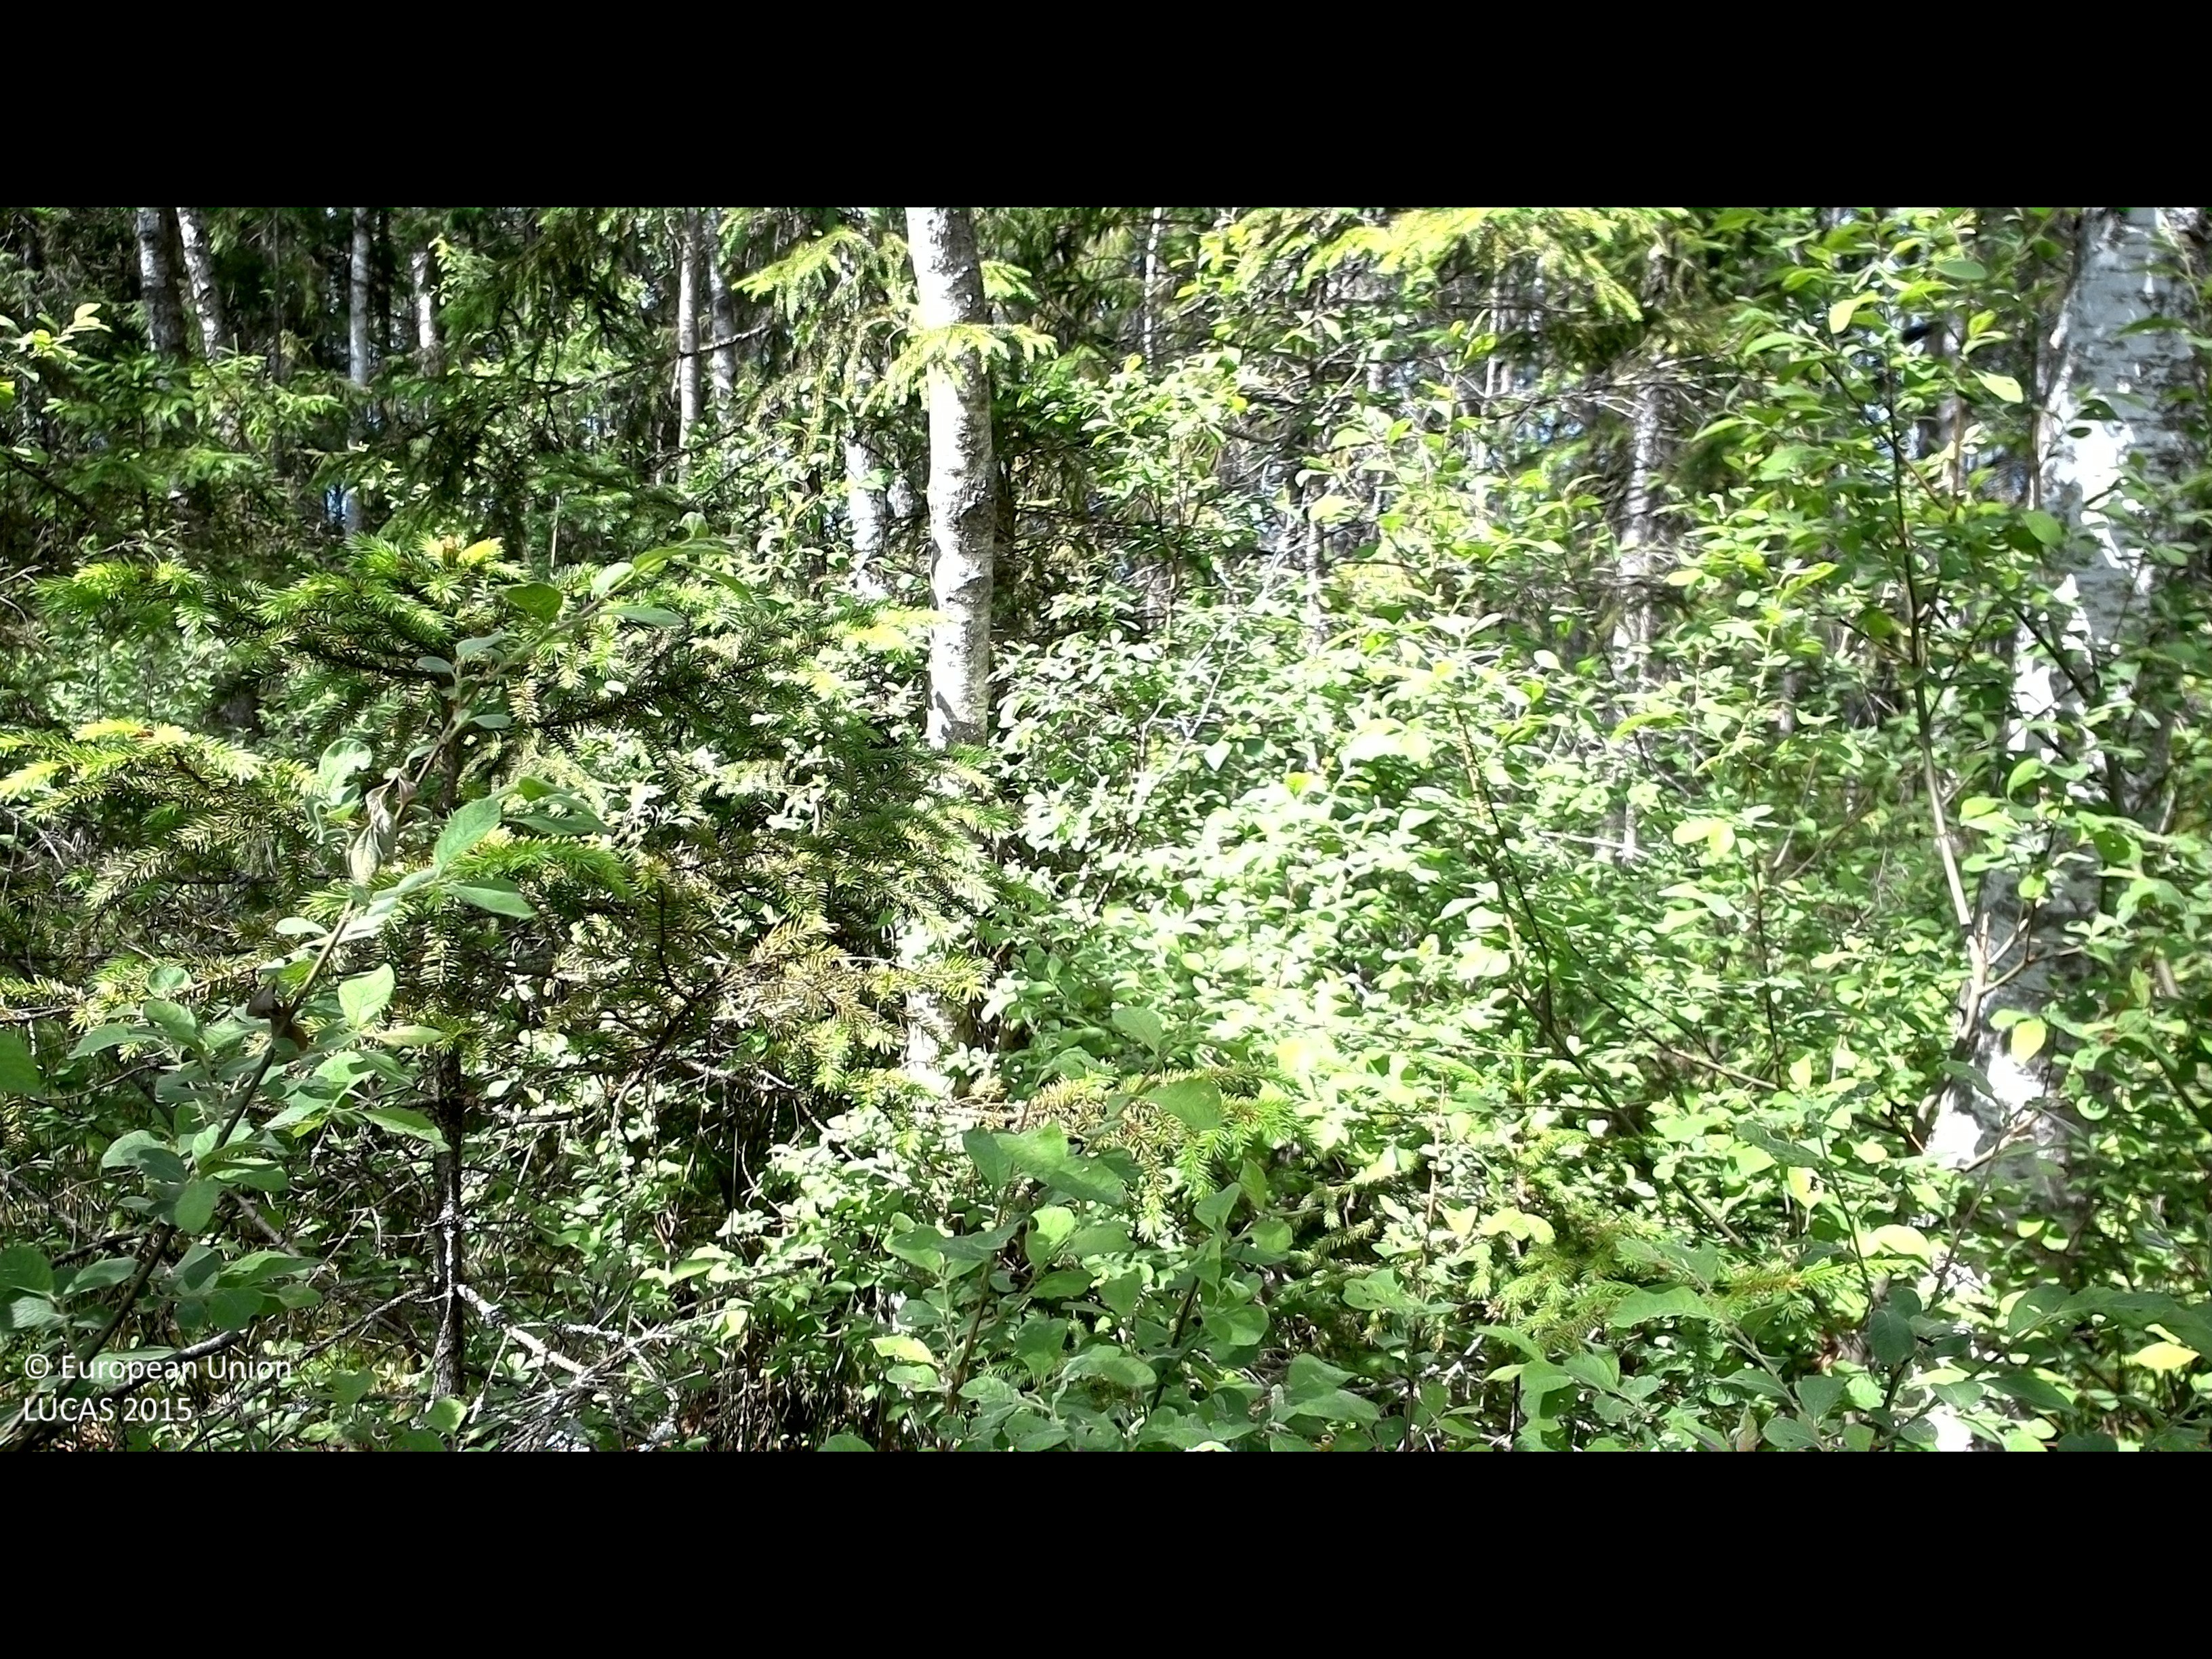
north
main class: Woodland
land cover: Broadleaved woodland
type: boreal forest
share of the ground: 50 - 75 %
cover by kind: broadleaved forest trees 50 %, lichens and mosses 25 %, coniferous forest trees 10 %, herbaceous plants 10 %, shrubs 5 %
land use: Forestry
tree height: > 5 m
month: July
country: SE
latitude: 56.4260
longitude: 15.1707
